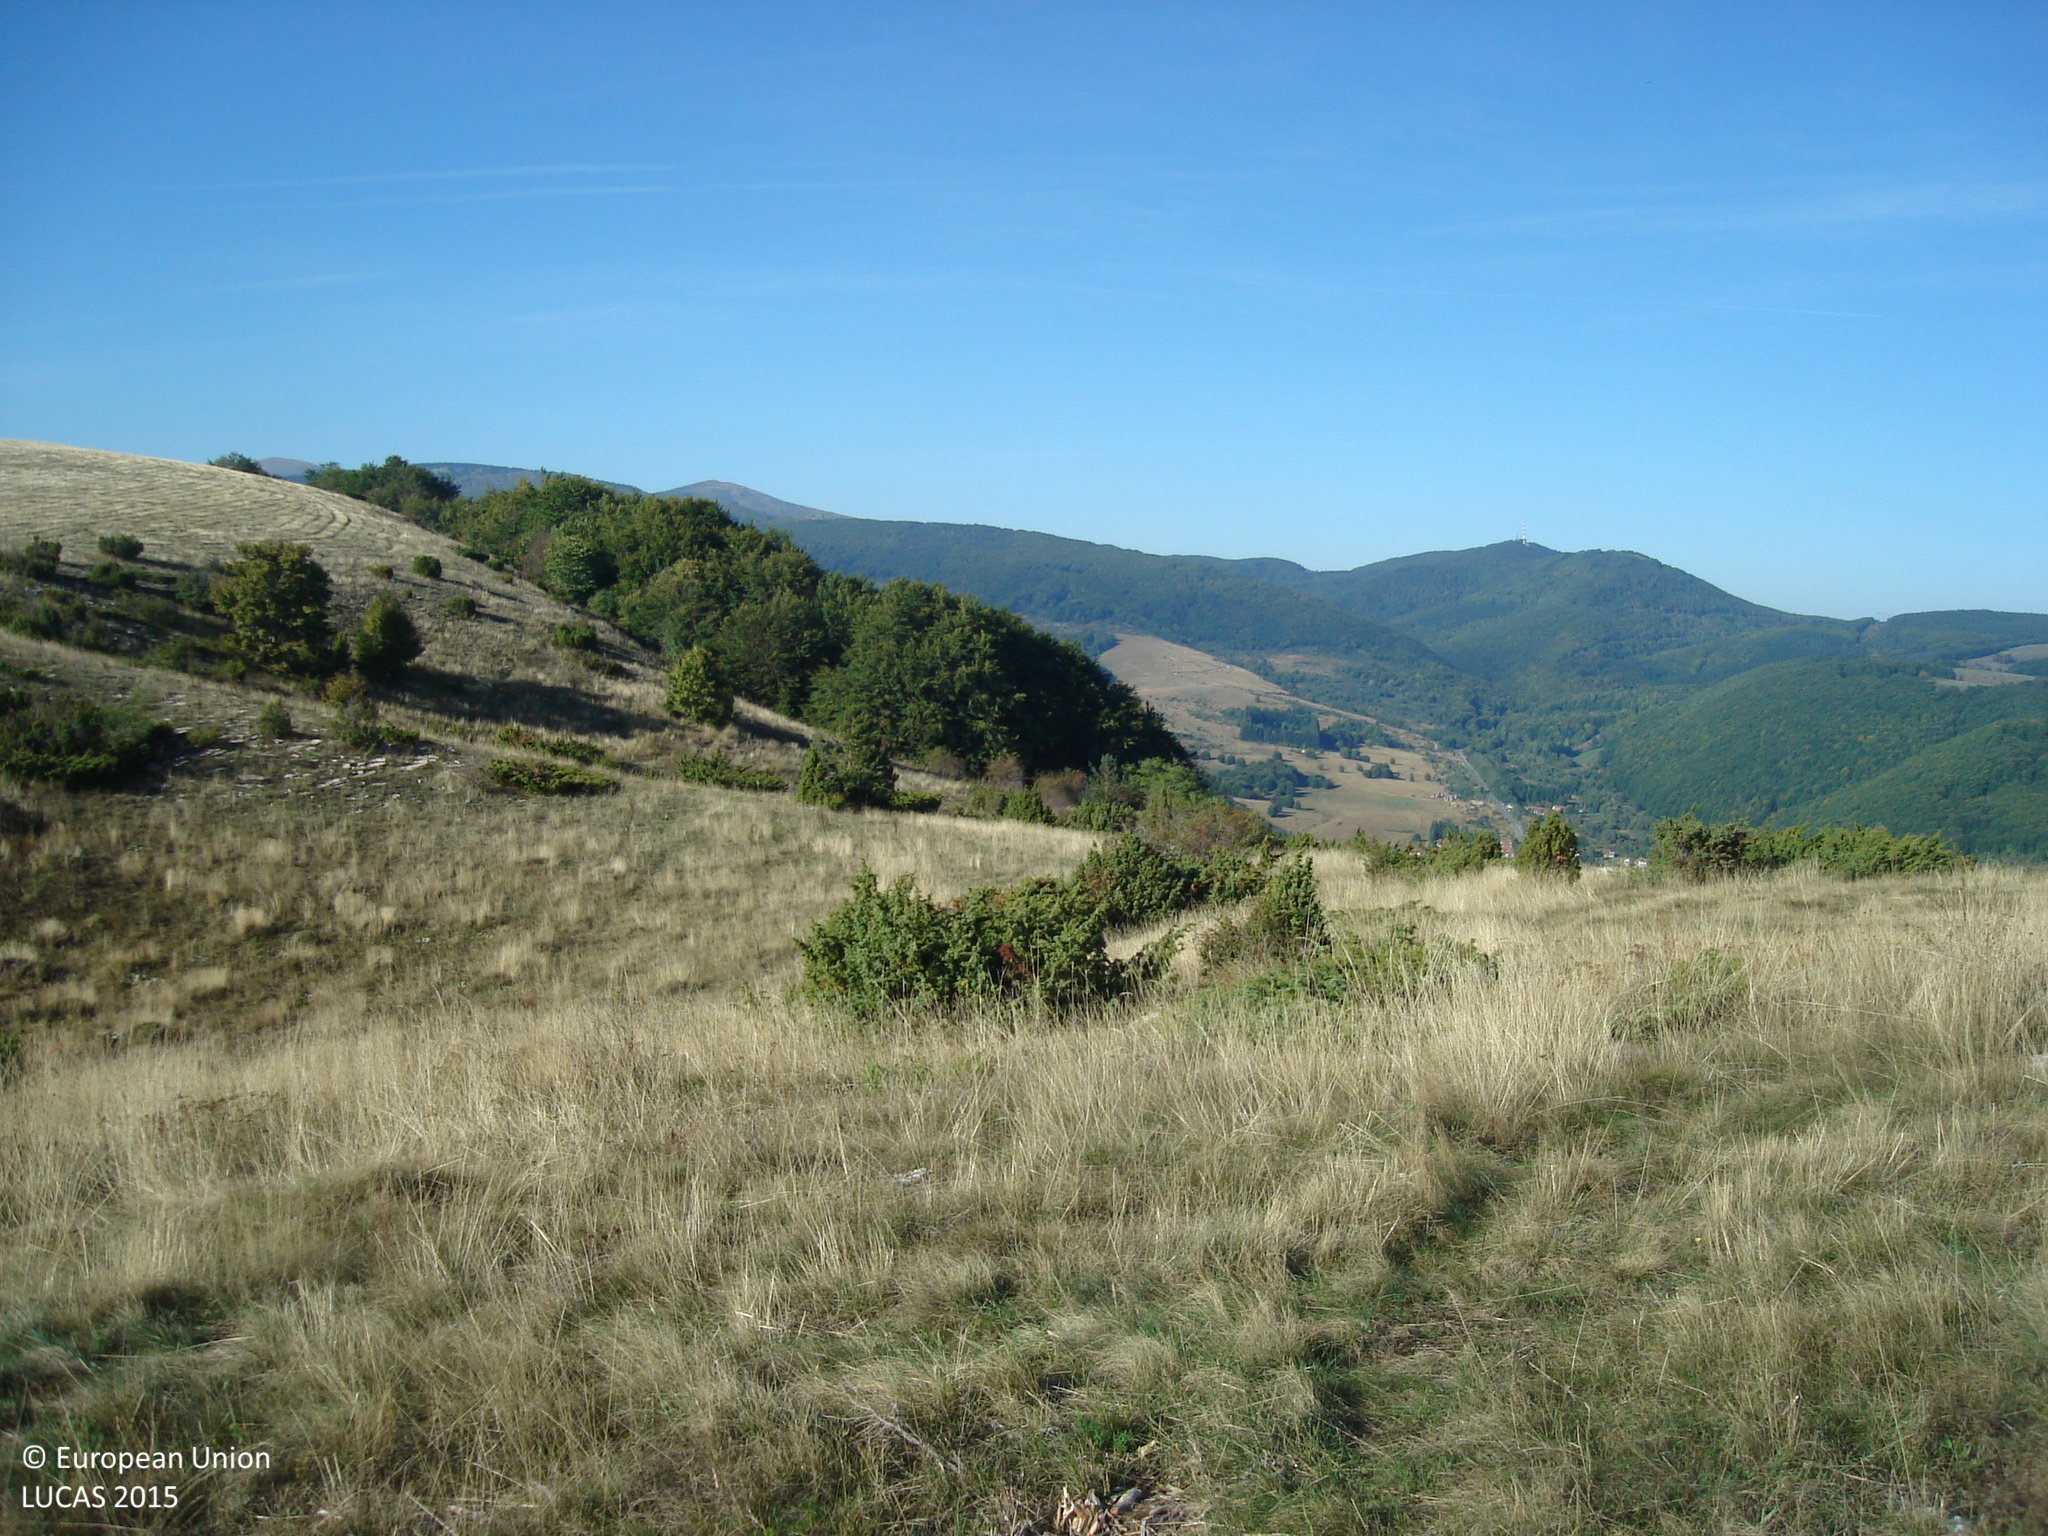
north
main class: Grassland
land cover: Grassland without tree/shrub cover
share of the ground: > 75 %
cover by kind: herbaceous plants 100 %
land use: Agriculture (excluding fallow land and kitchen gardens)
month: October
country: BG
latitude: 43.0790
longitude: 23.0909
